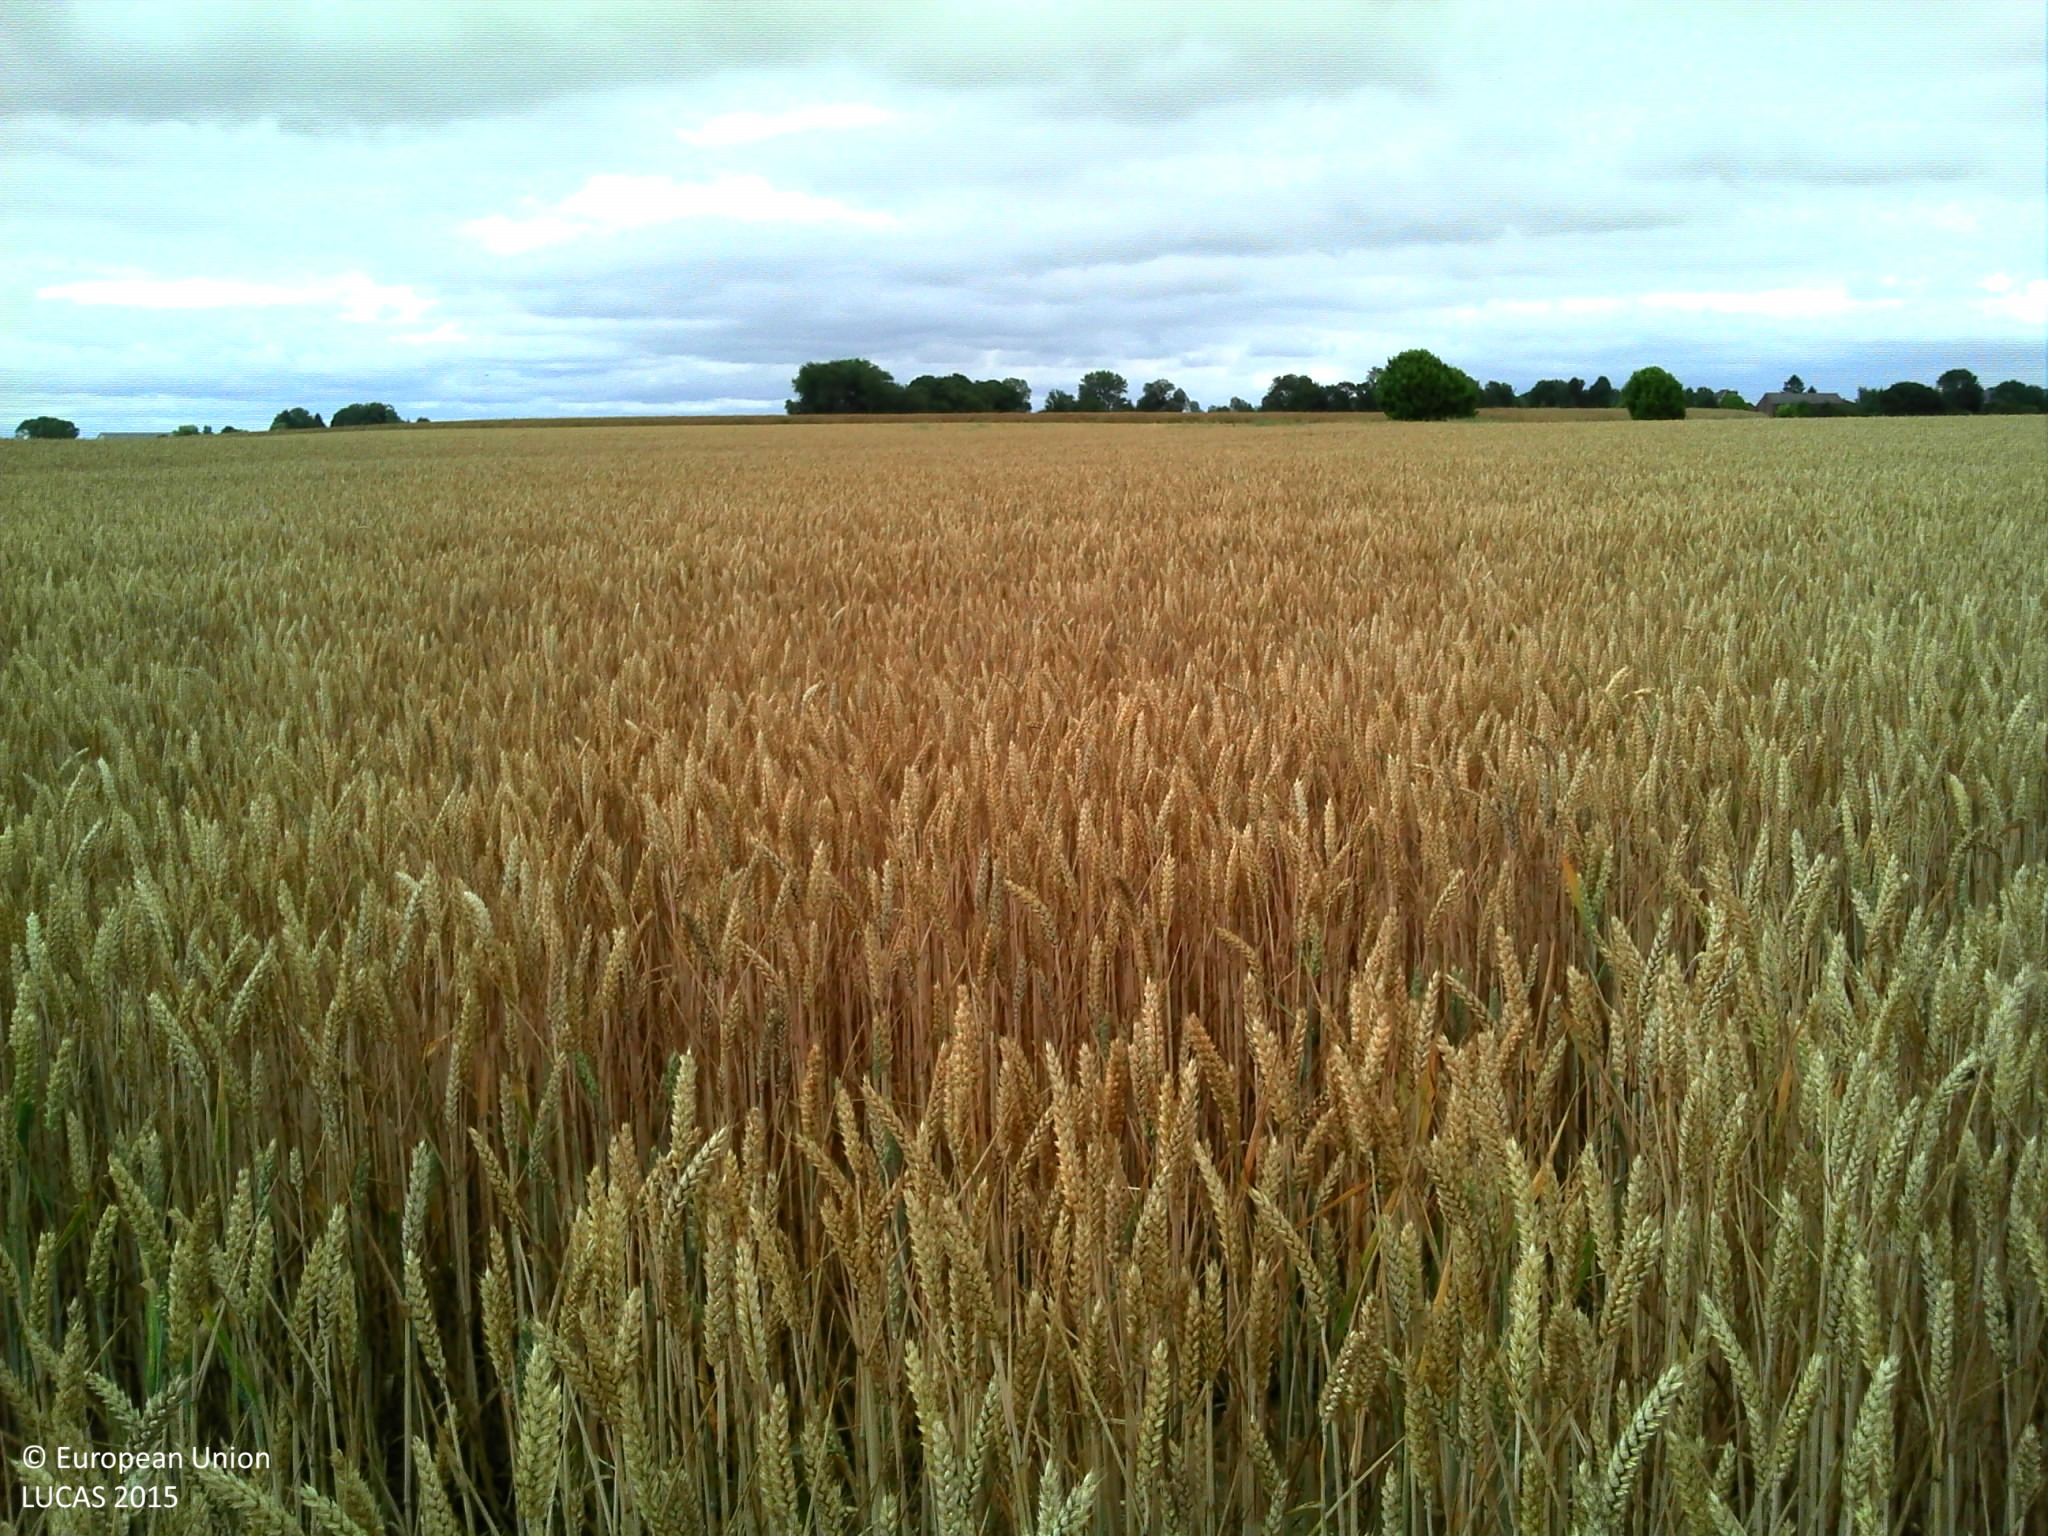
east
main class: Cropland
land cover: Common wheat
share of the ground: > 75 %
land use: Agriculture (excluding fallow land and kitchen gardens)
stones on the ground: < 10 %
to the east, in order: Common wheat; Spontaneously vegetated surfaces; Paved roads, cycling and walking lanes; Spontaneously vegetated surfaces; Common wheat; Rape and turnip rape
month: July
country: FR
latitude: 50.0365
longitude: 3.2198
